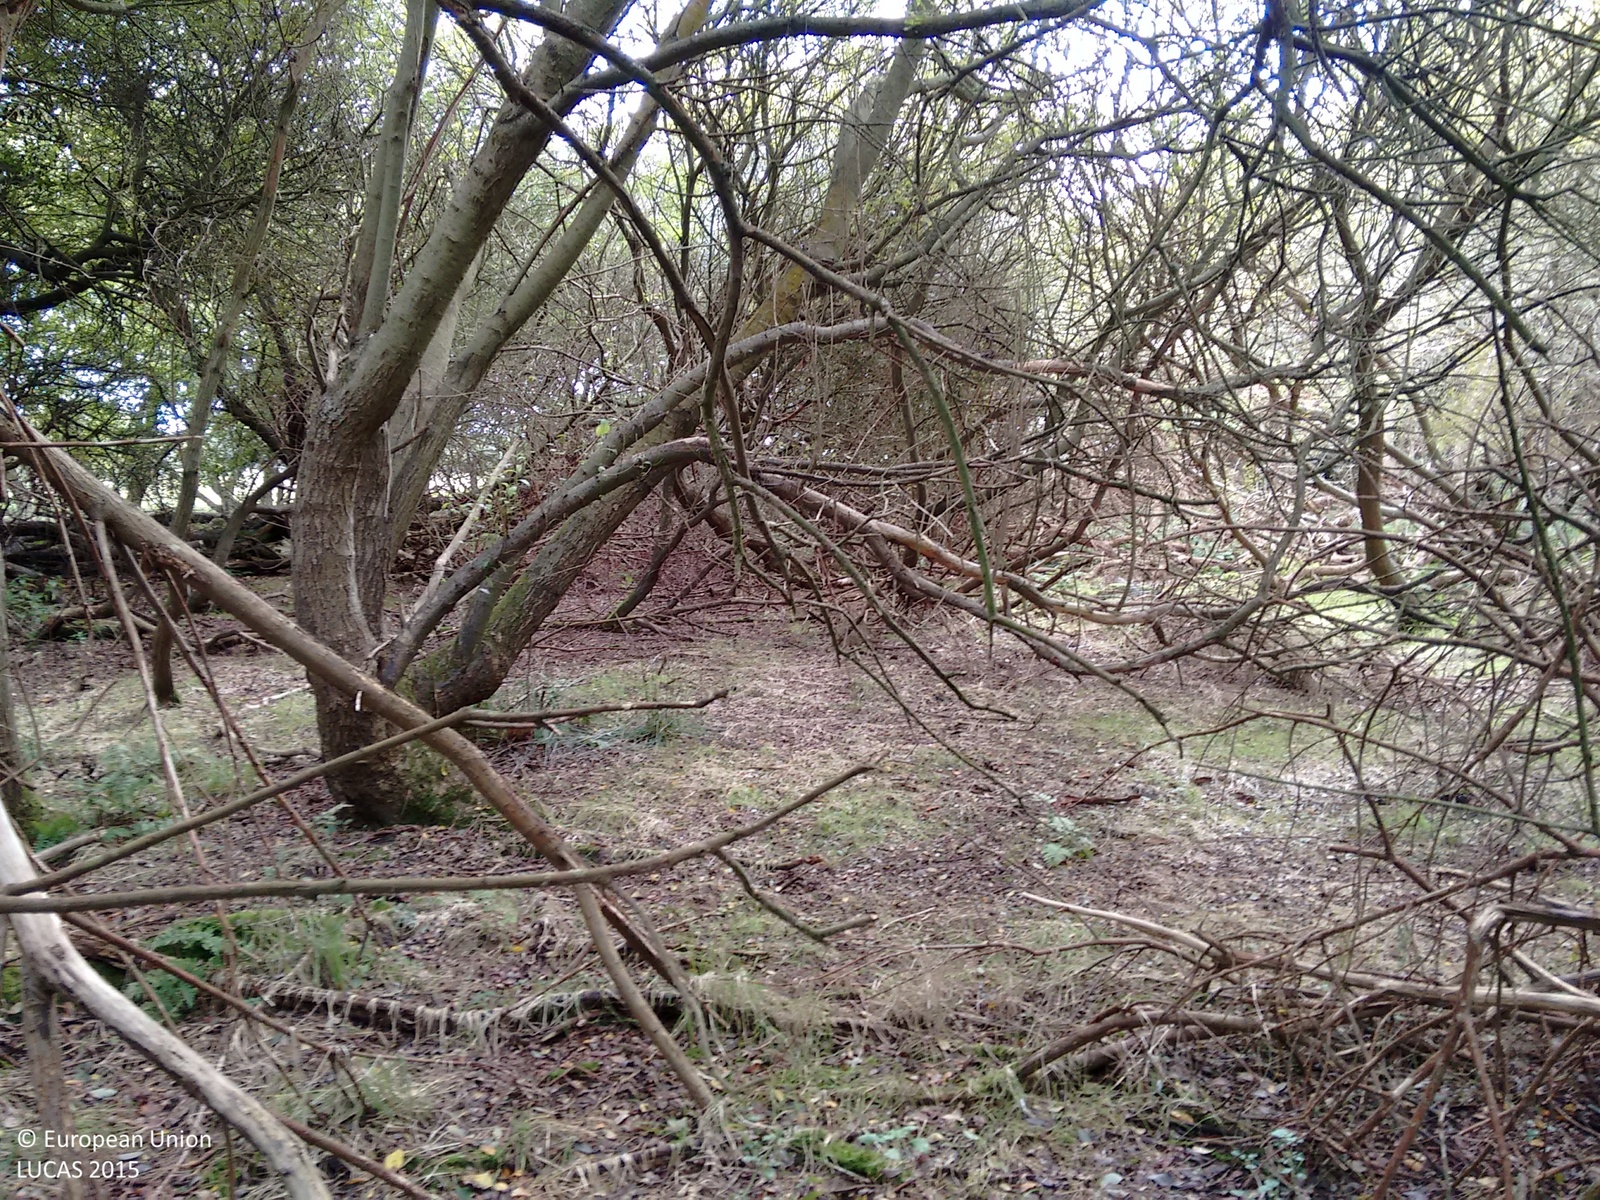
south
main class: Woodland
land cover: Other mixed woodland
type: mesophytic deciduous forest
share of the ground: > 75 %
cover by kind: broadleaved forest trees 75 %, coniferous forest trees 25 %
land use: Forestry
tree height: > 5 m
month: September
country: GB
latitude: 52.7353
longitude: 1.6739
